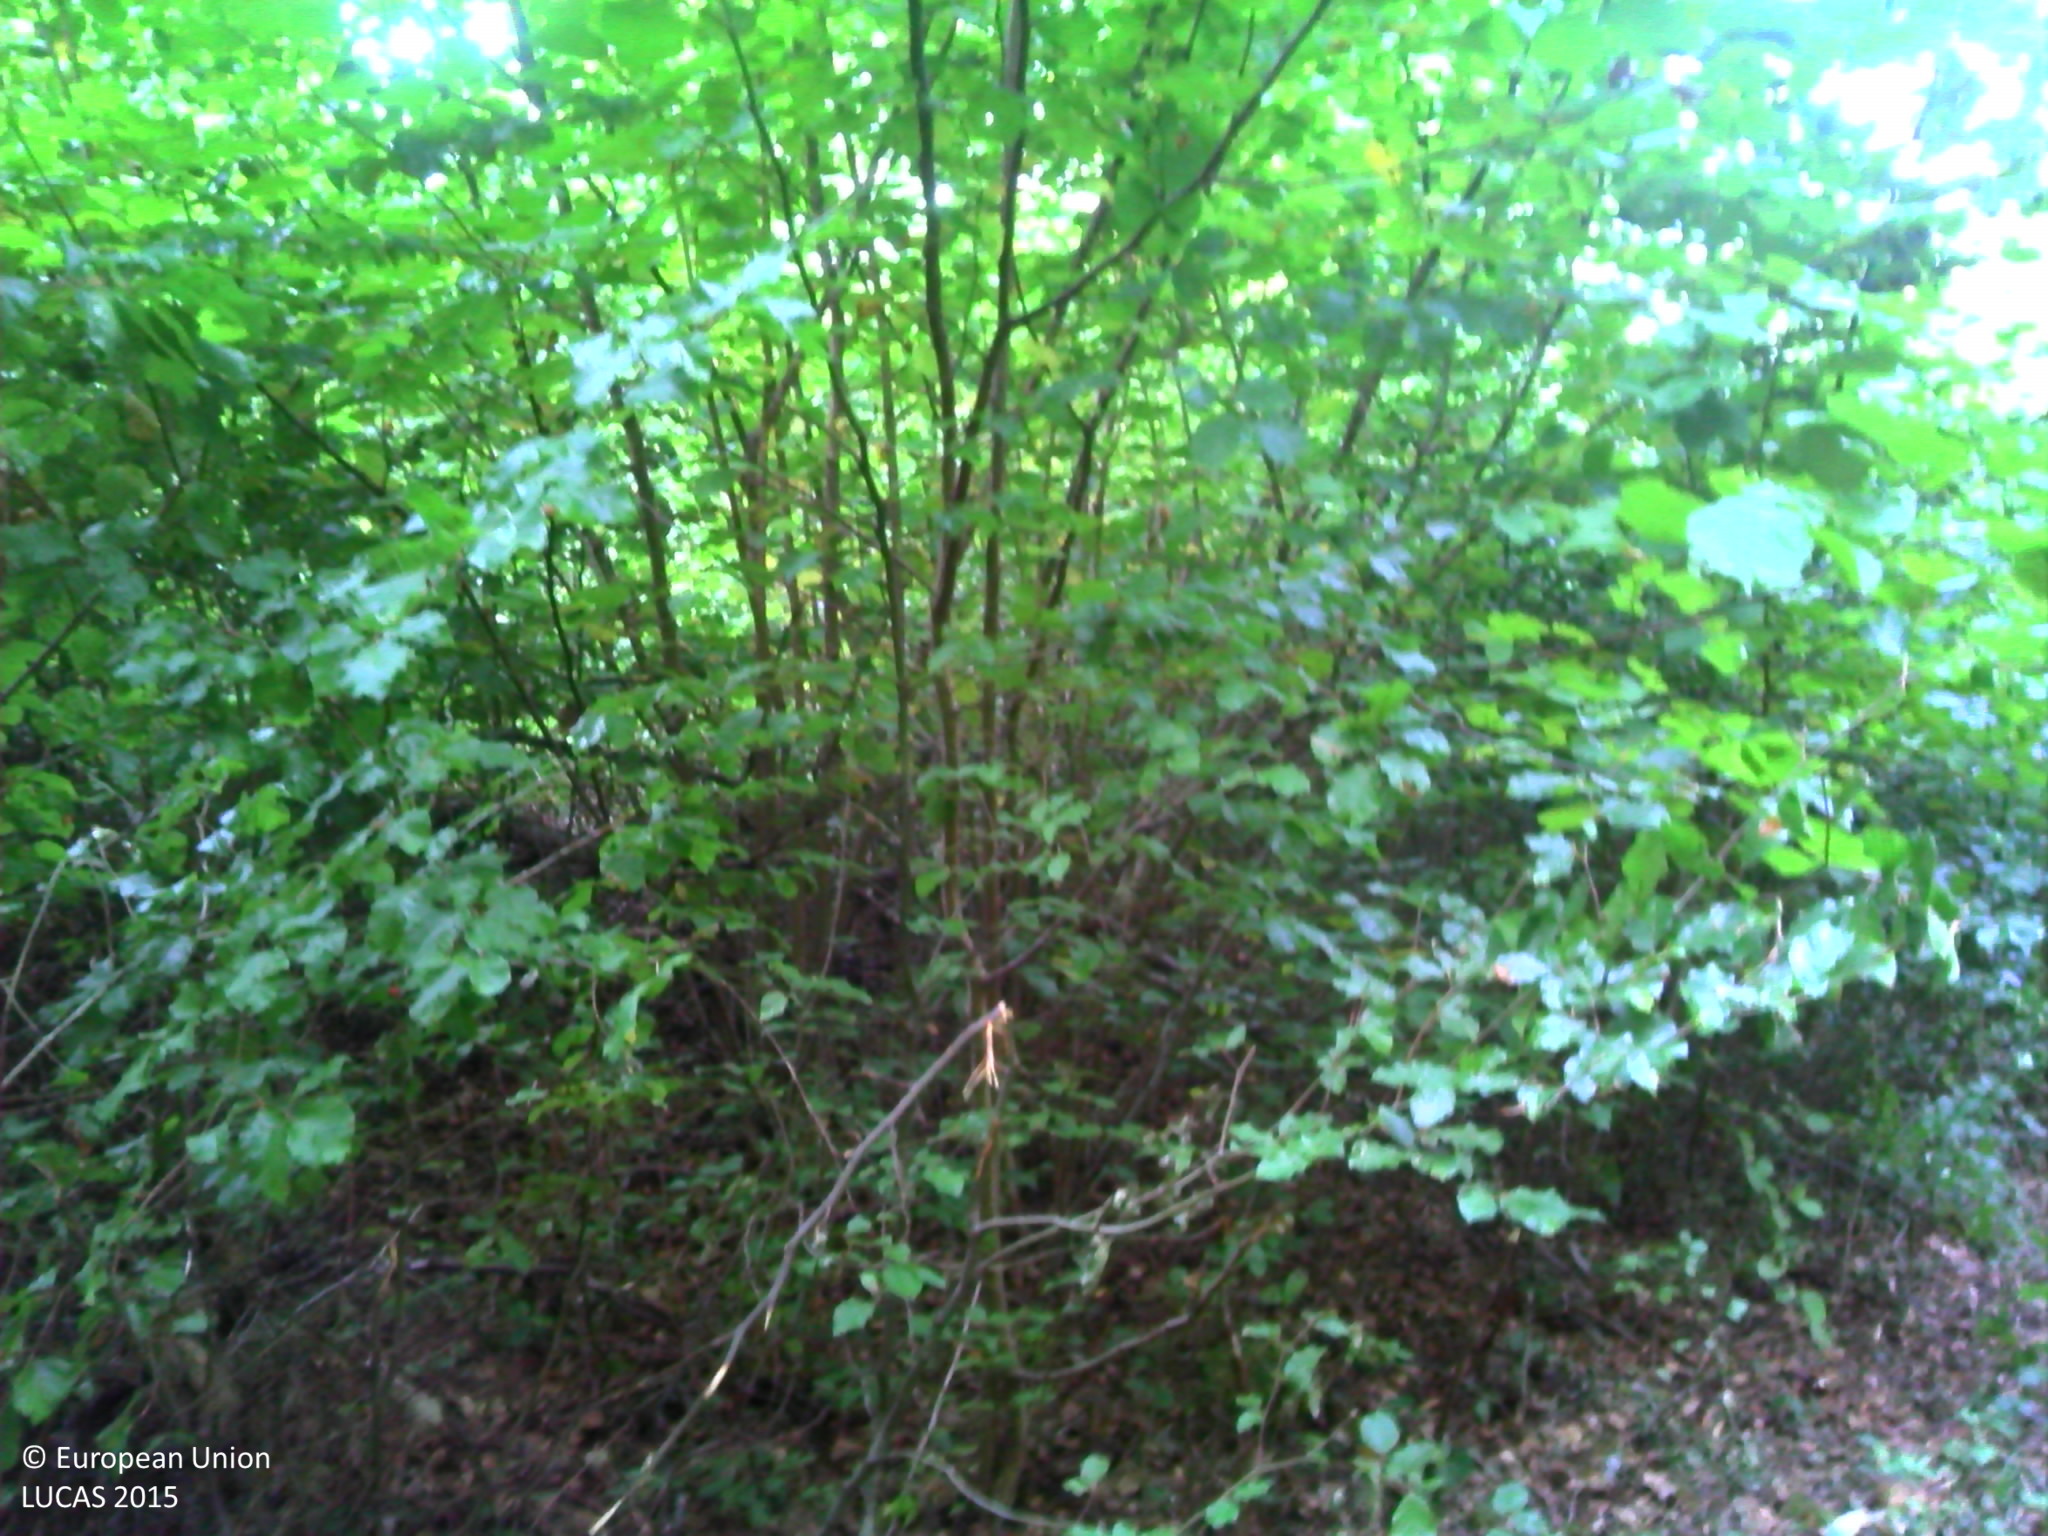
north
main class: Woodland
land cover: Broadleaved woodland
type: beech forest
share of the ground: > 75 %
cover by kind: broadleaved forest trees 90 %, consolidated bare surface 5 %
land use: Forestry
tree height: > 5 m
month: September
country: FR
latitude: 47.2449
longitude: 6.3687
